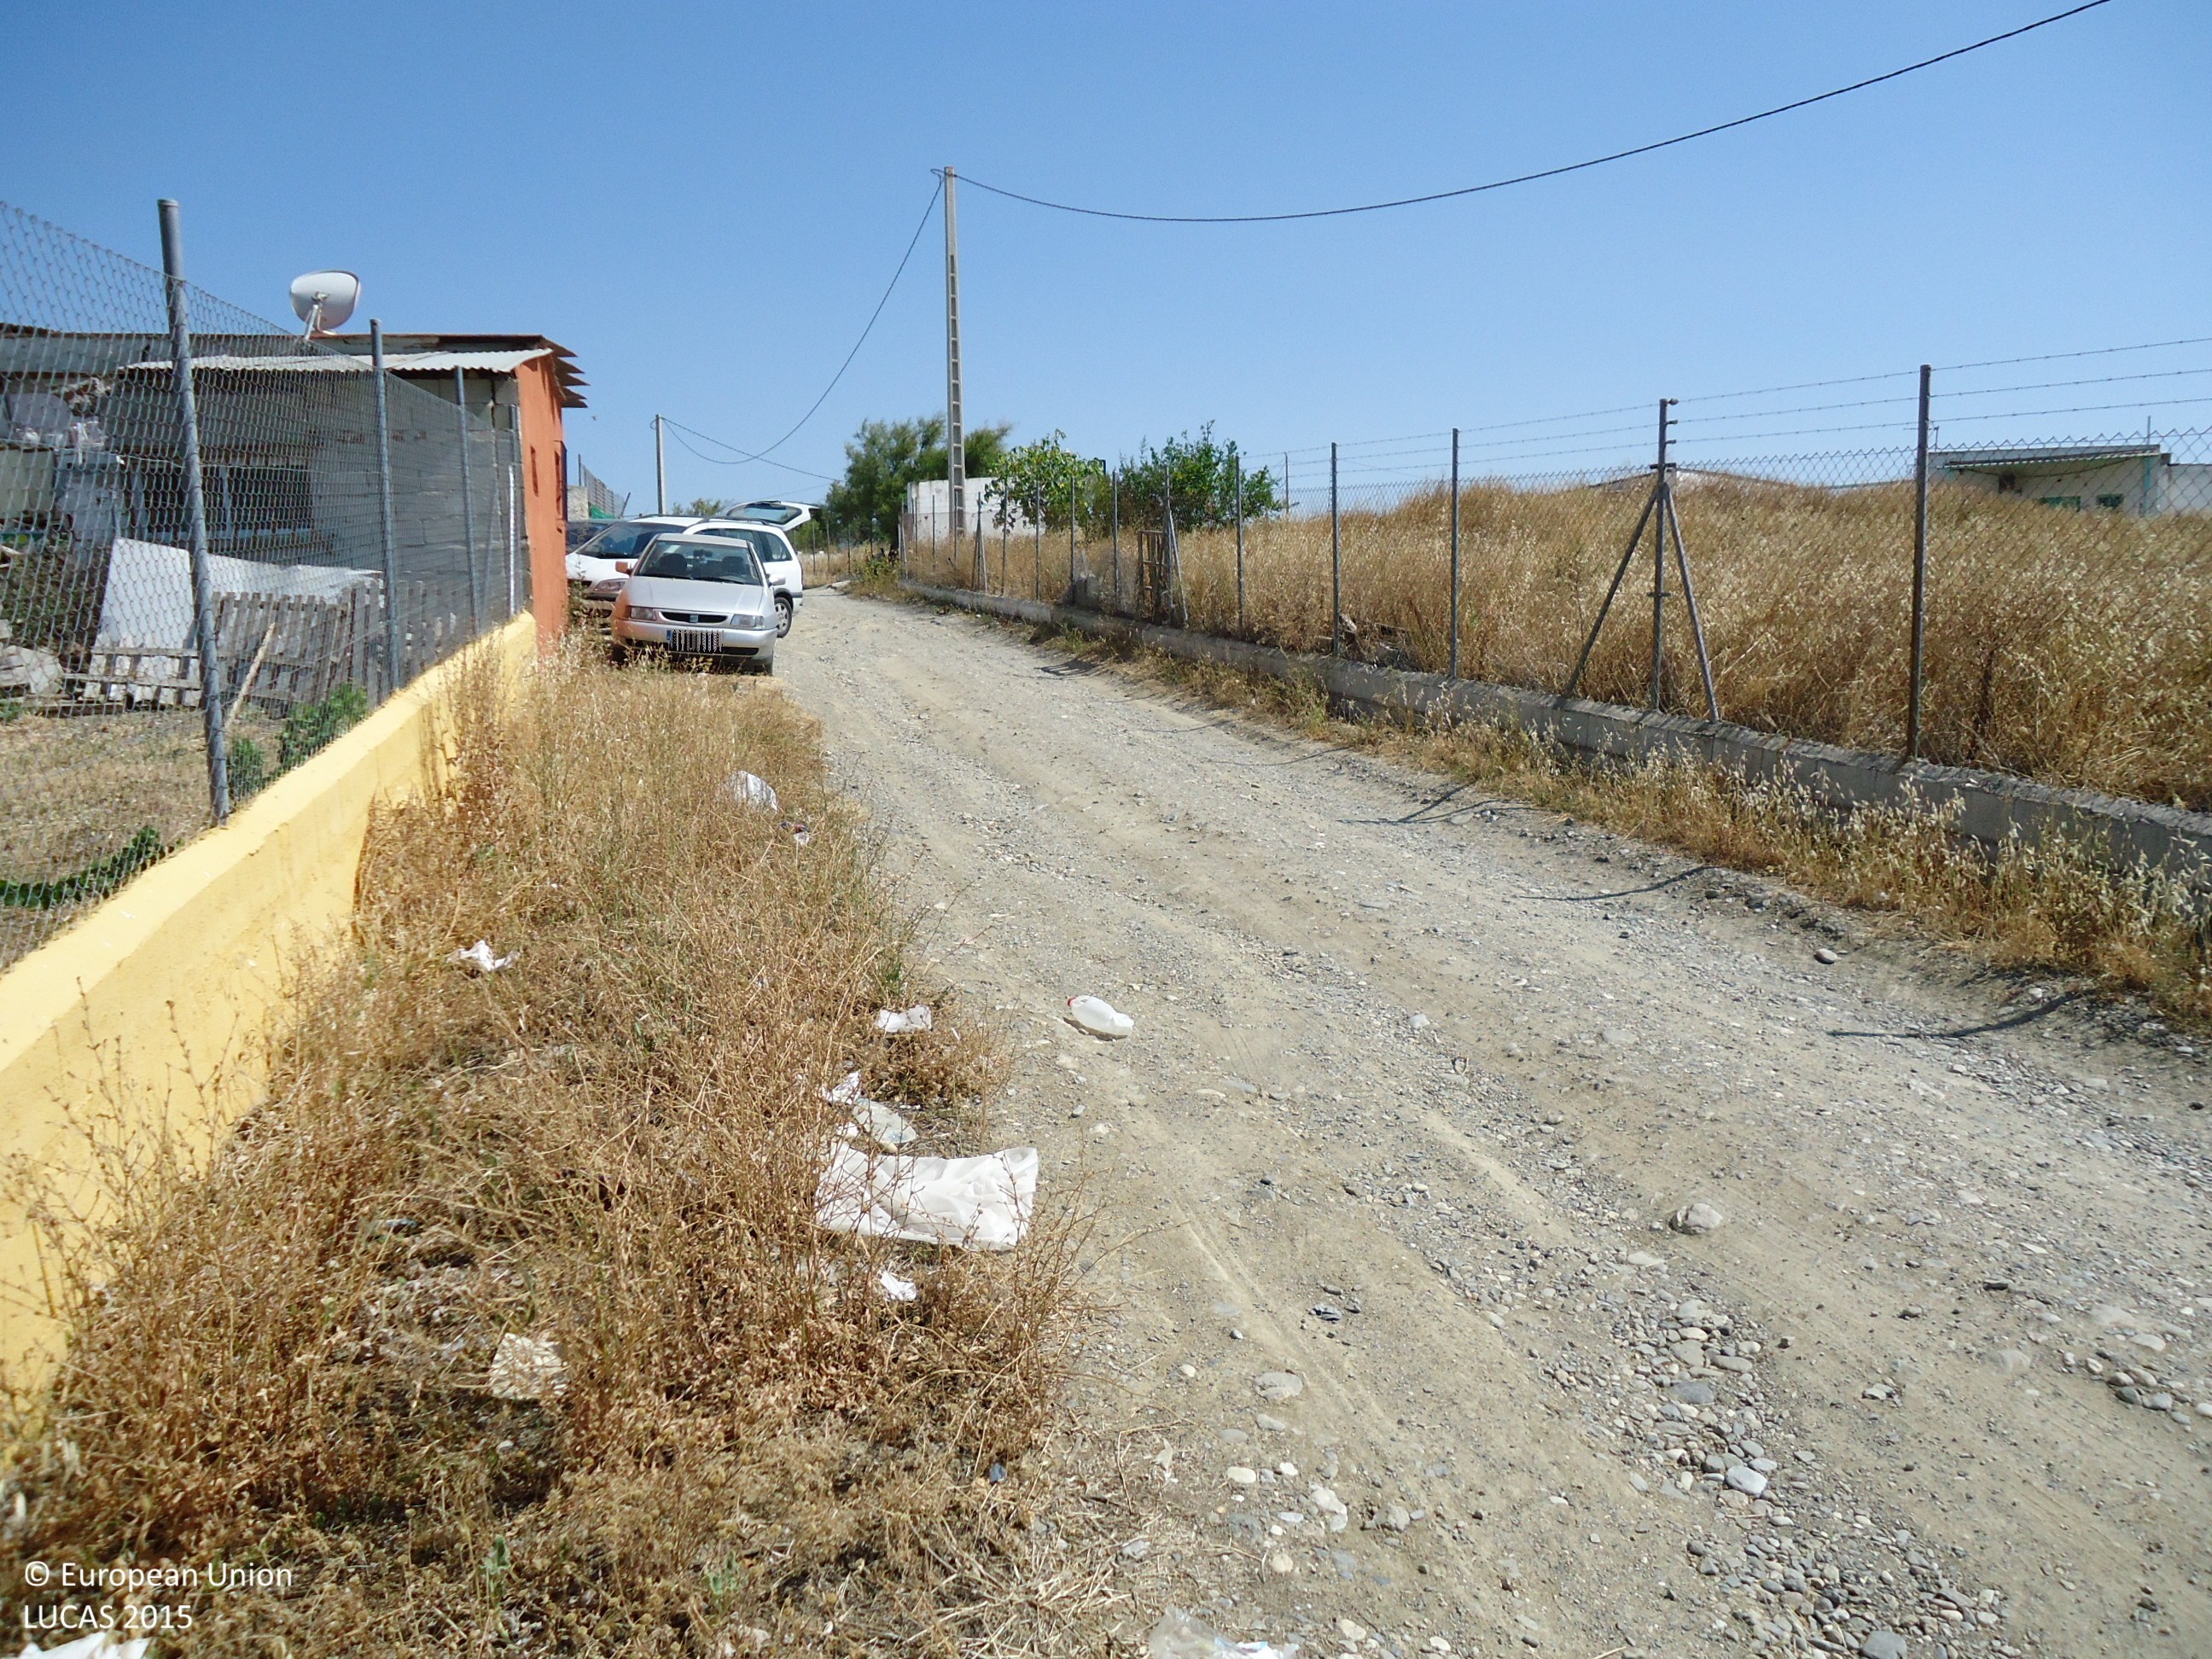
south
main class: Cropland
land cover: Other fresh vegetables
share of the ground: 25 - 50 %
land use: Kitchen garden
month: June
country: ES
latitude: 36.7102
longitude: -4.6913
